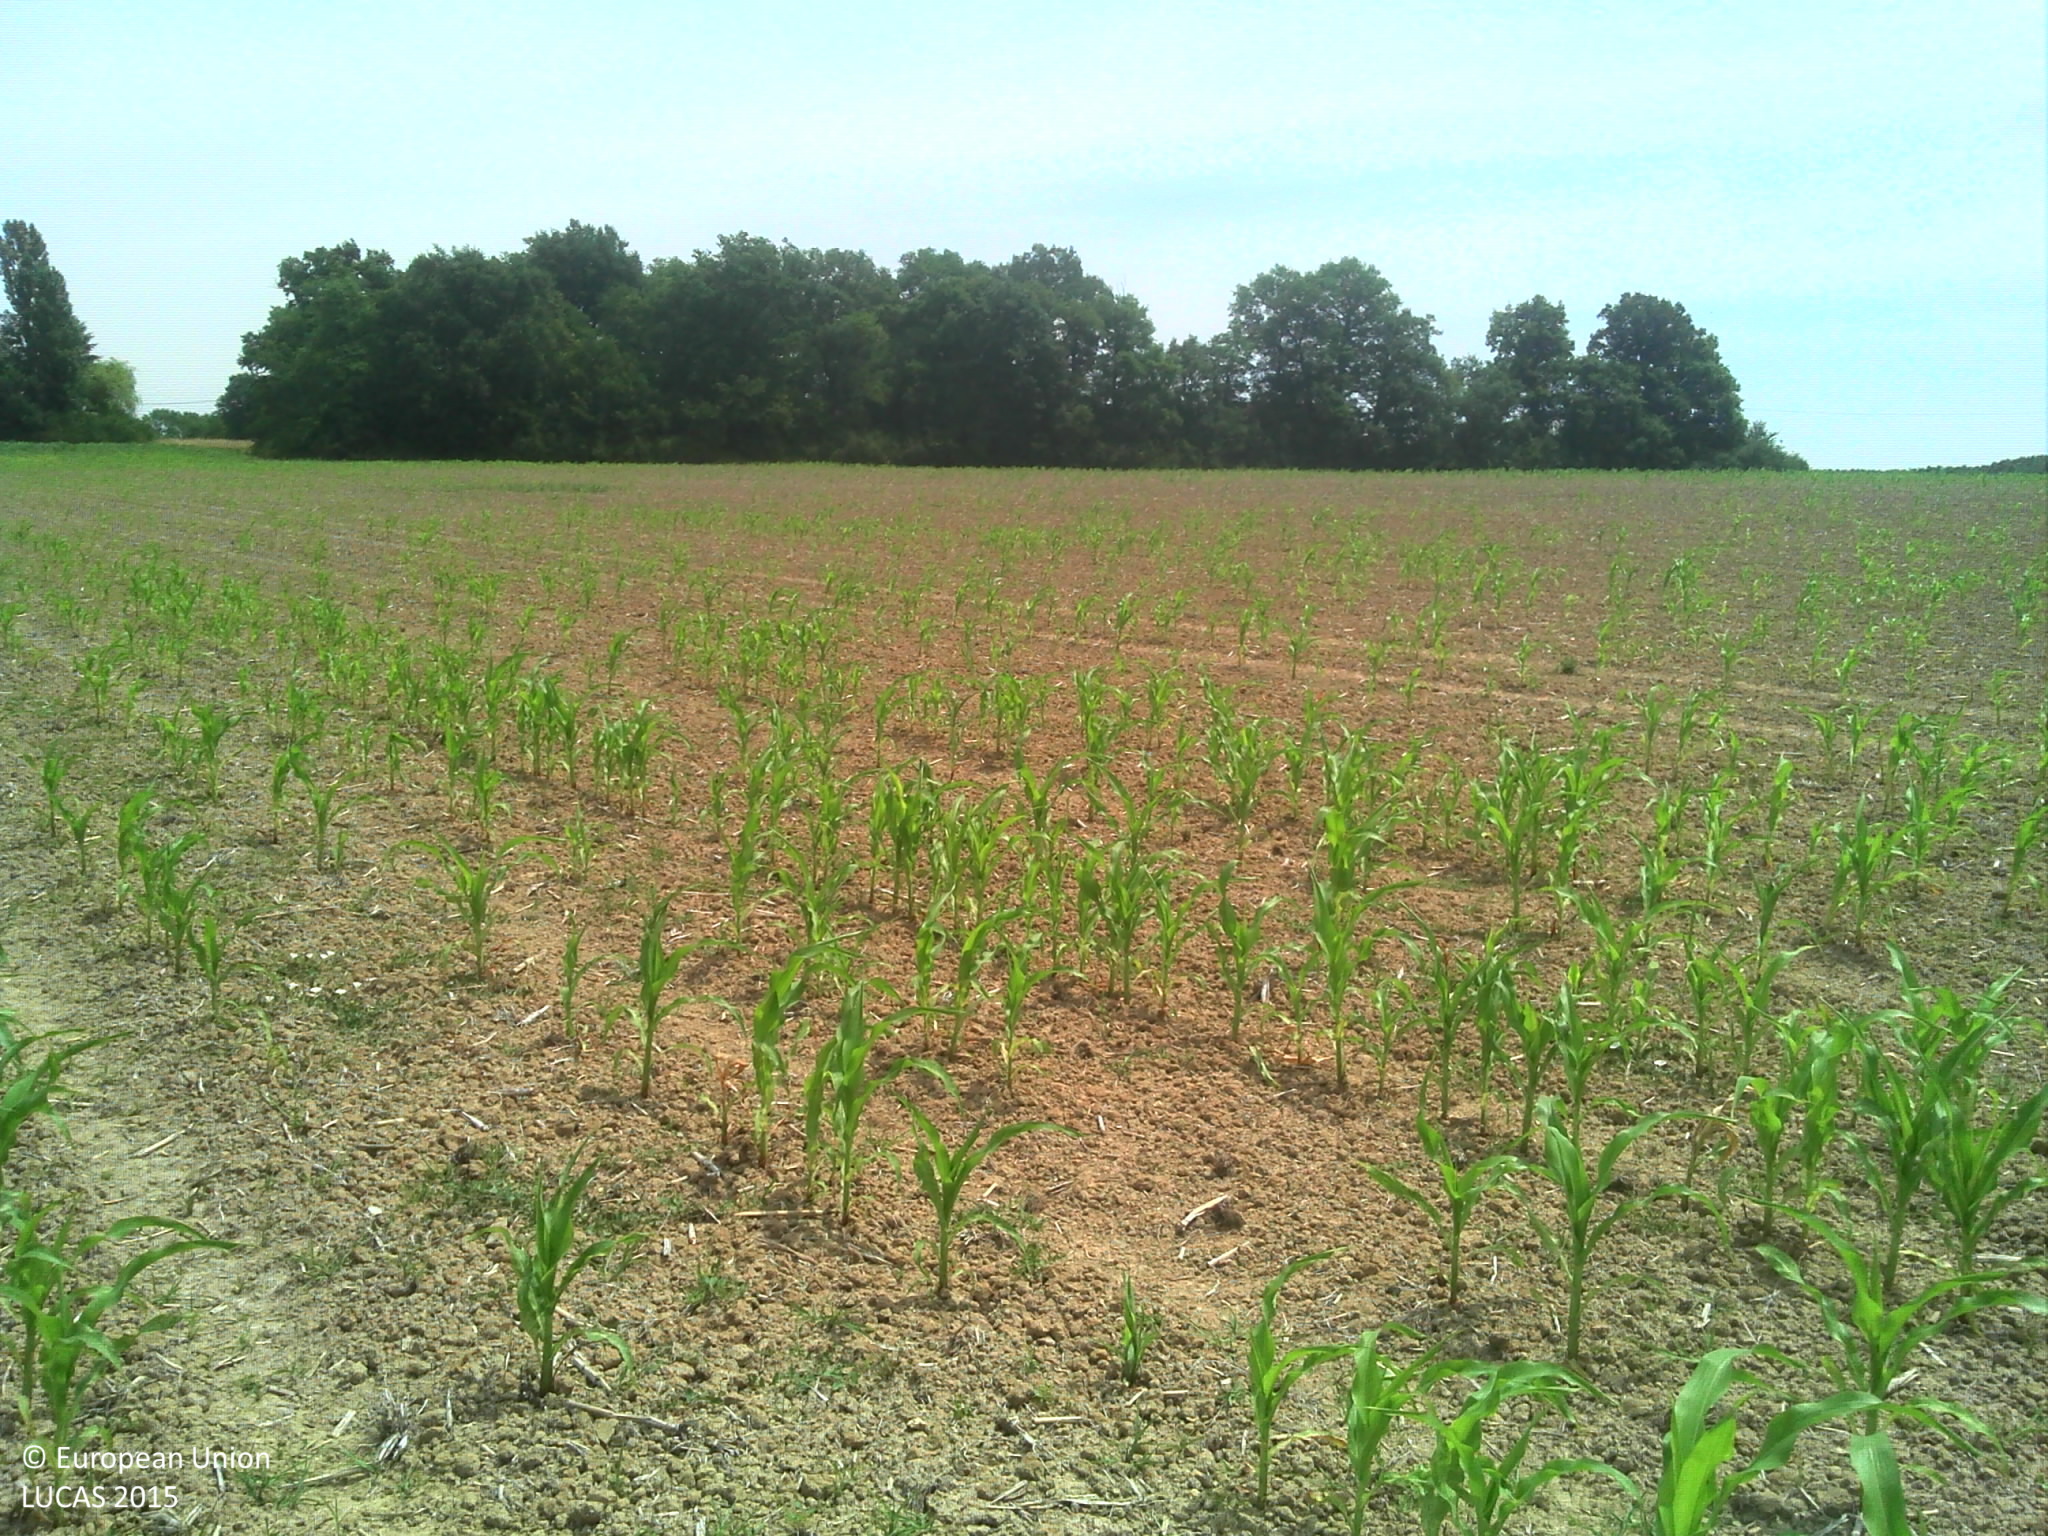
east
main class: Cropland
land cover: Maize
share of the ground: 25 - 50 %
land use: Agriculture (excluding fallow land and kitchen gardens)
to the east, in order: Maize; Broadleaved woodland; Grassland without tree/shrub cover
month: June
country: FR
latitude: 47.4667
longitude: 1.3485
